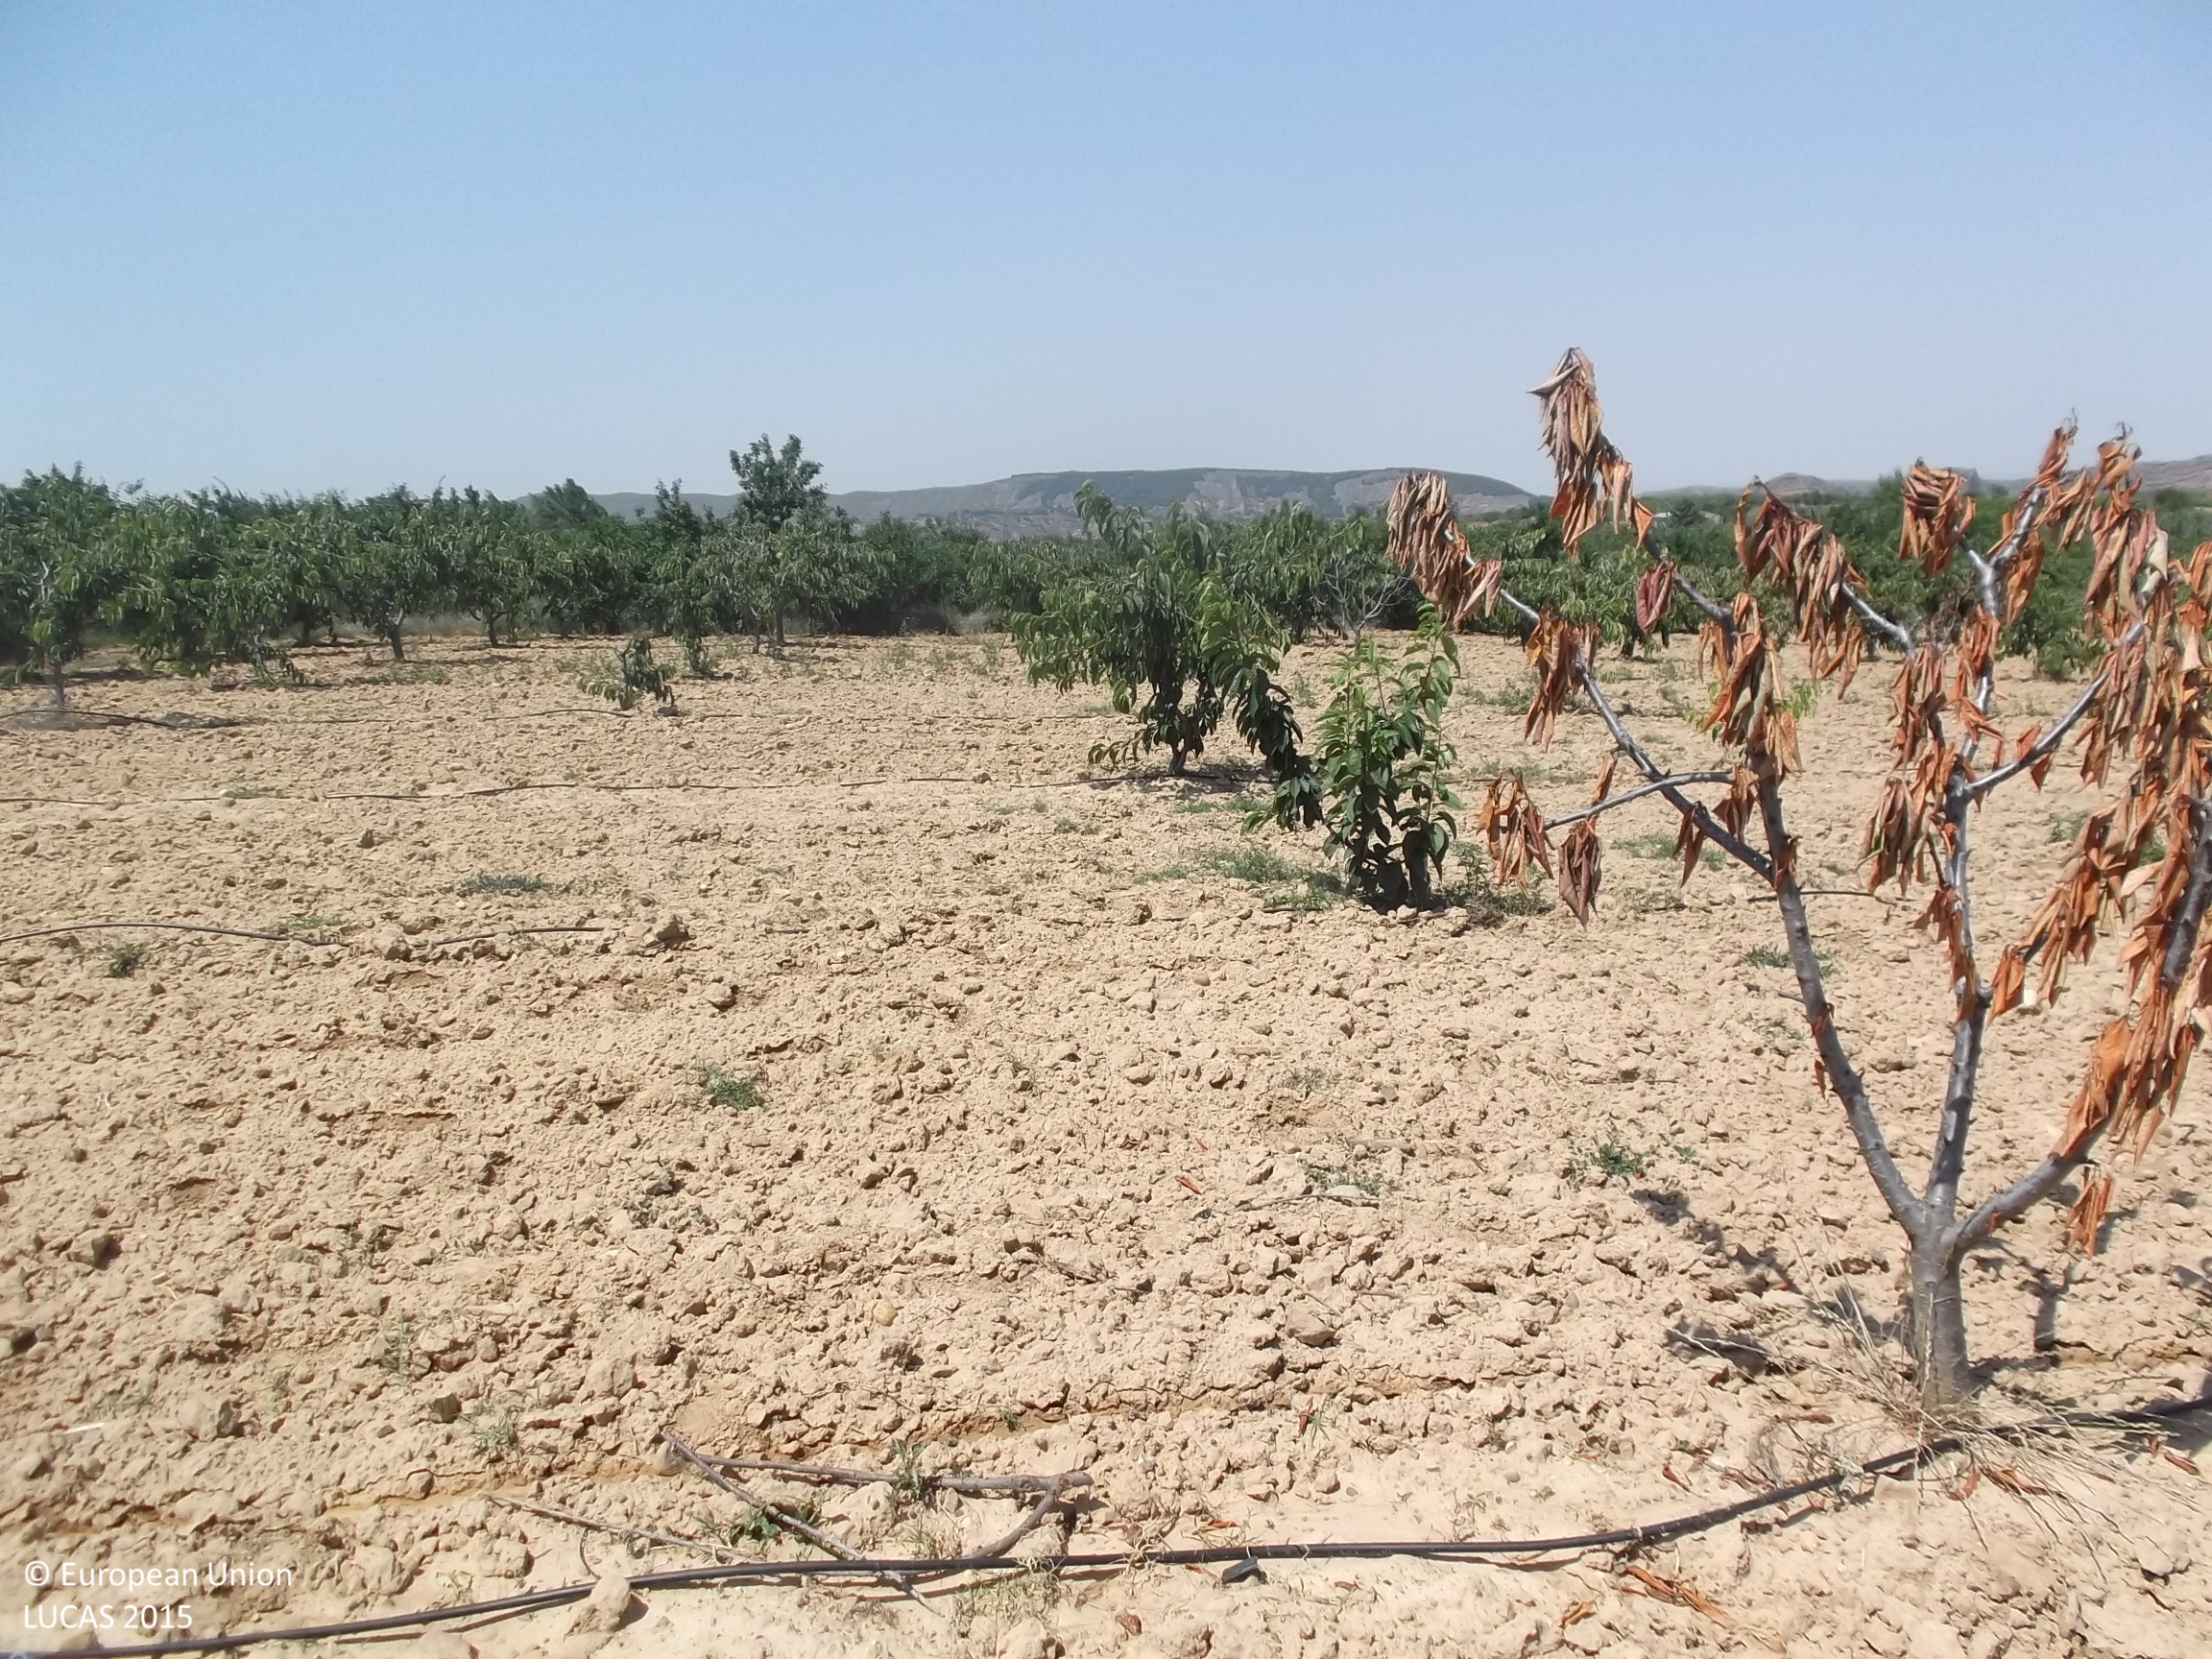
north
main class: Cropland
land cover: Cherry fruit
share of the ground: 10 - 25 %
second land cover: Other bare soil
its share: > 75 %
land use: Agriculture (excluding fallow land and kitchen gardens)
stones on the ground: < 10 %
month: June
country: ES
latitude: 42.2037
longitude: -2.0646
